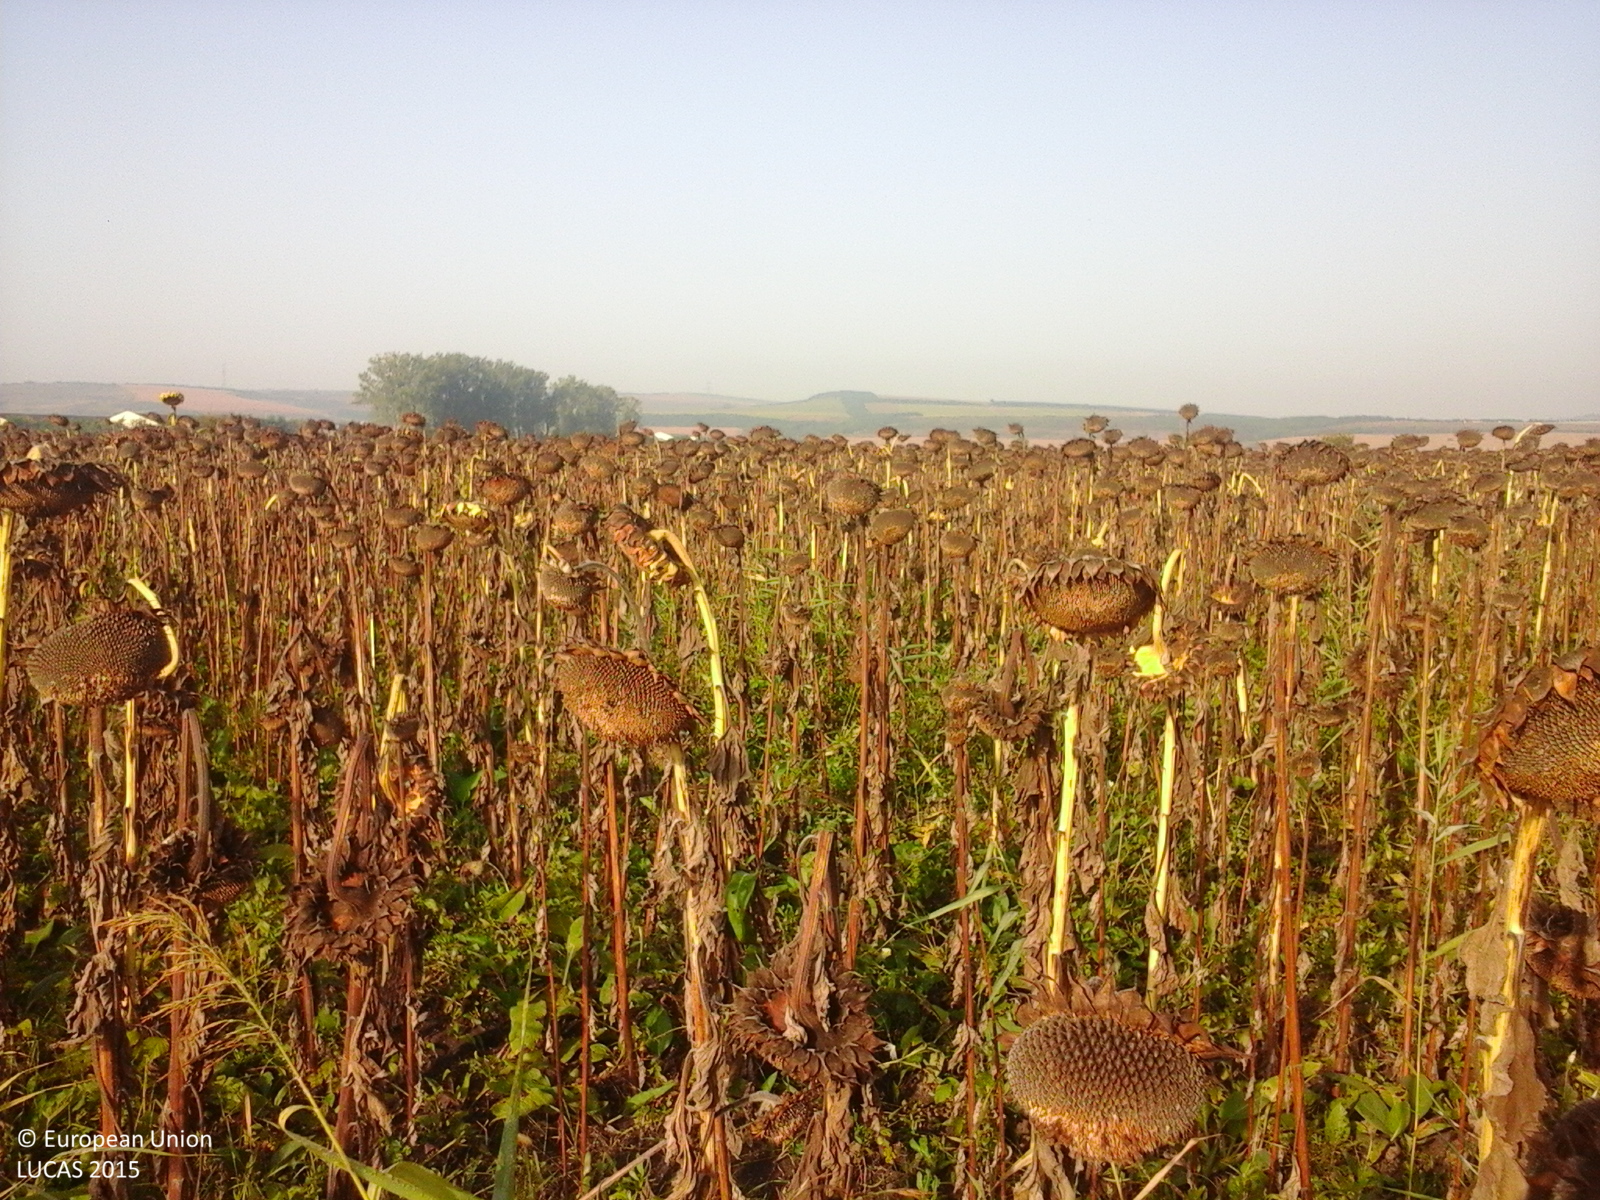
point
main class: Cropland
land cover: Sunflower
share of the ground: > 75 %
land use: Agriculture (excluding fallow land and kitchen gardens)
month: September
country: RO
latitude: 46.9304
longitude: 23.8011
